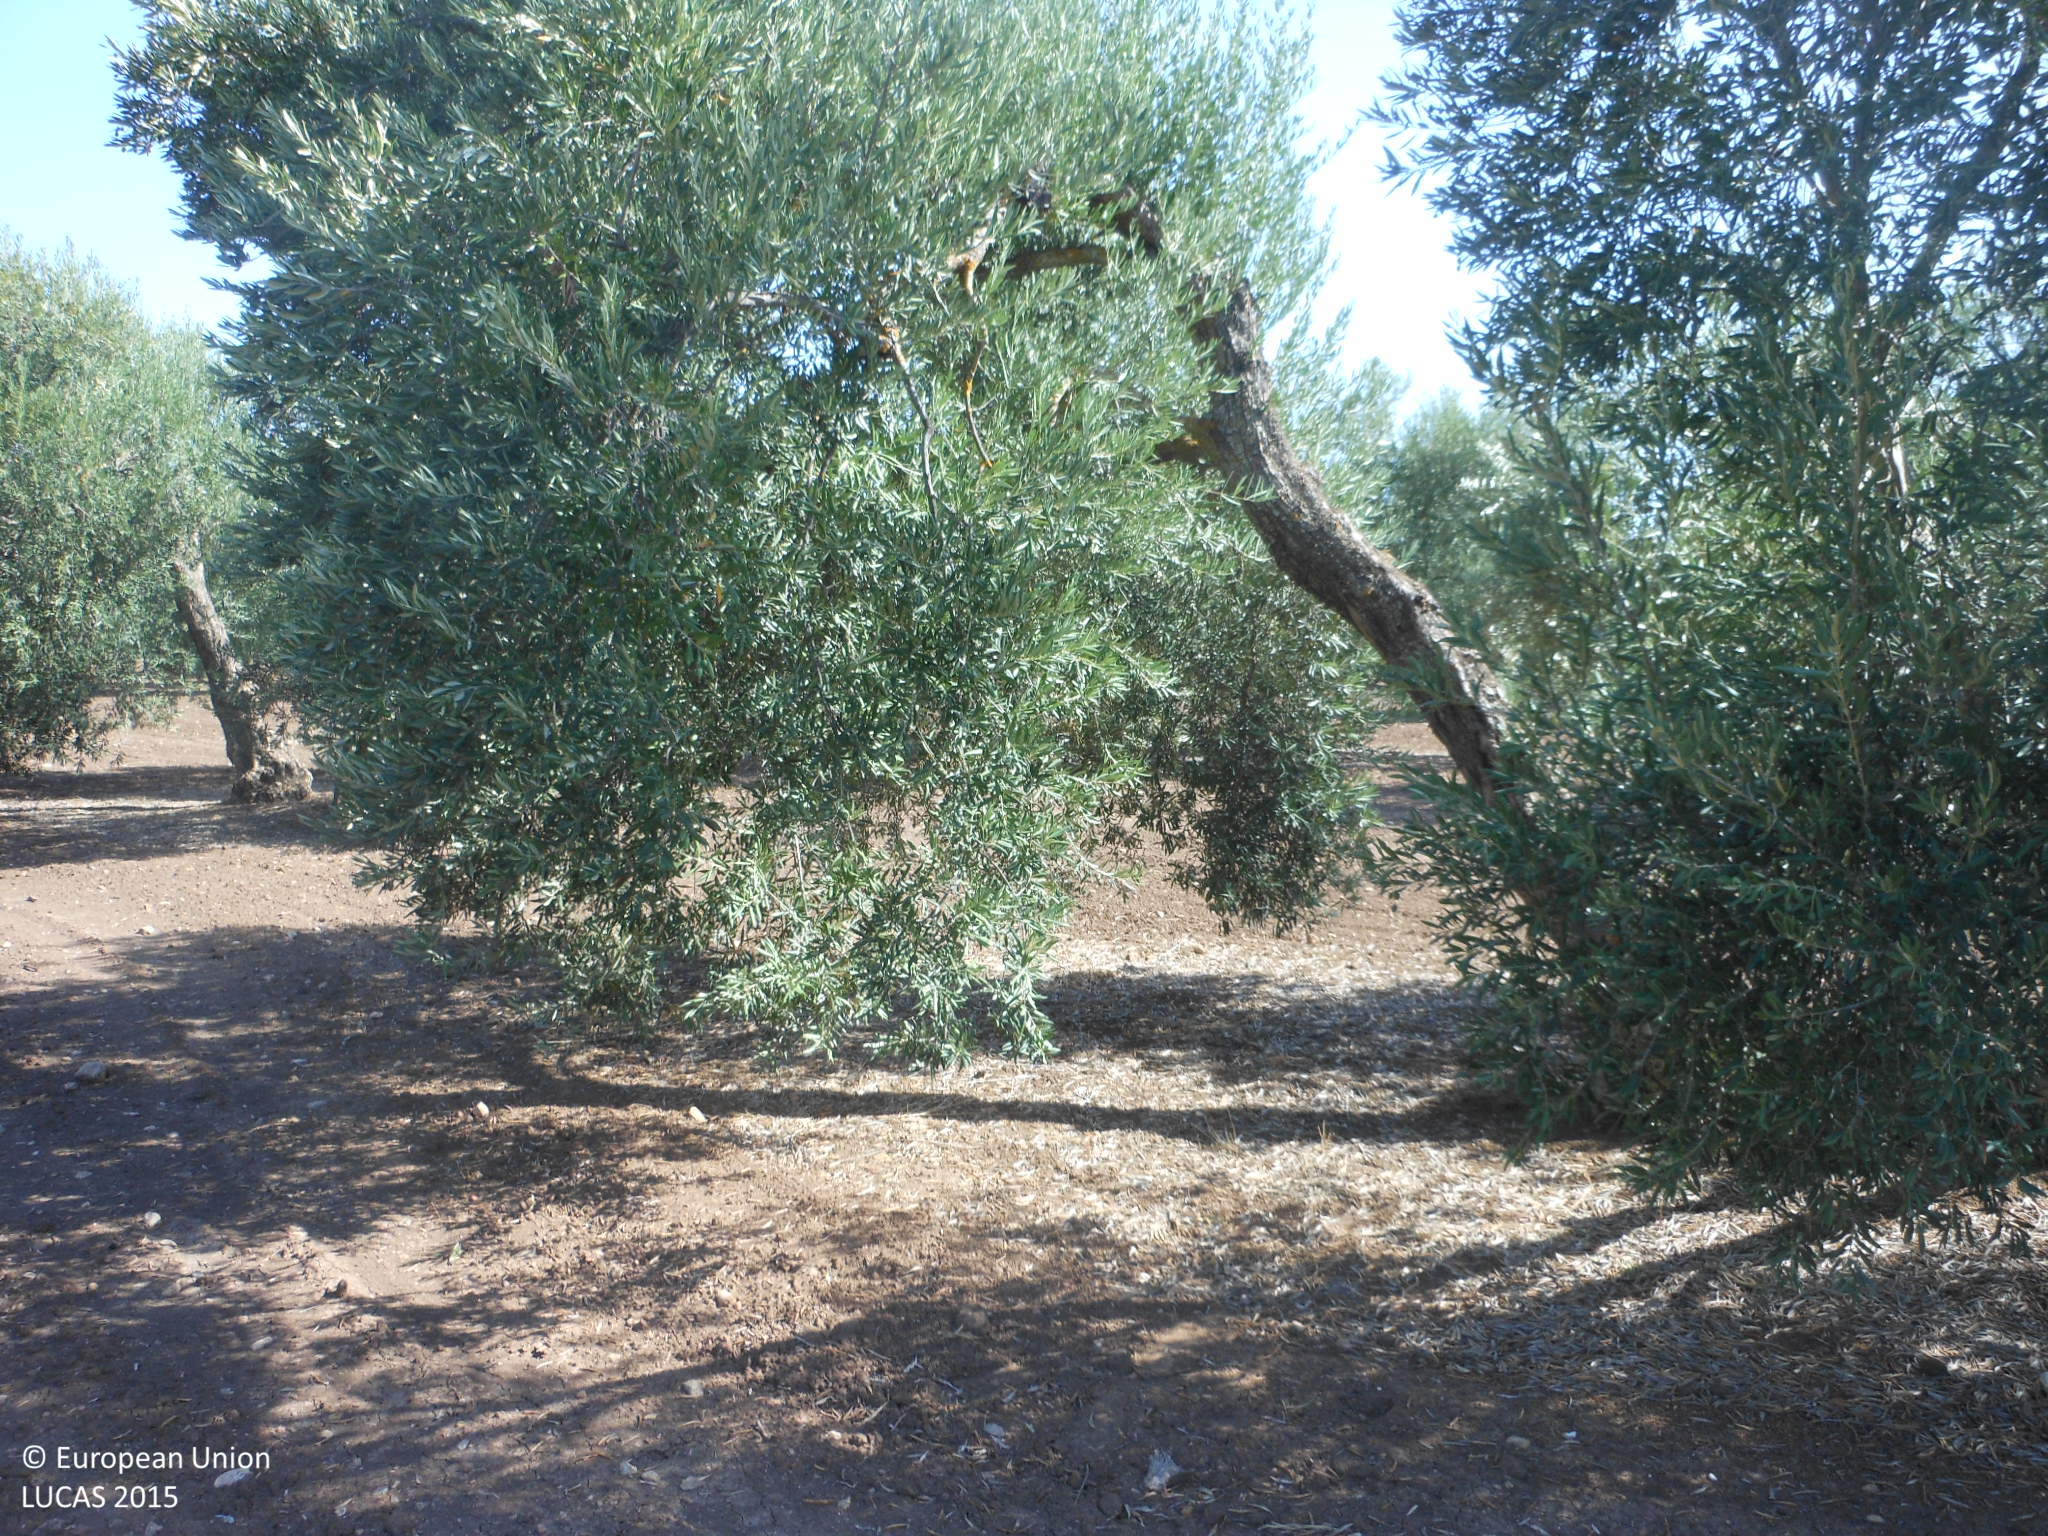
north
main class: Cropland
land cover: Olive groves
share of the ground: 25 - 50 %
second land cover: Other bare soil
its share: > 75 %
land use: Agriculture (excluding fallow land and kitchen gardens)
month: July
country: ES
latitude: 37.2121
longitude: -5.3467
